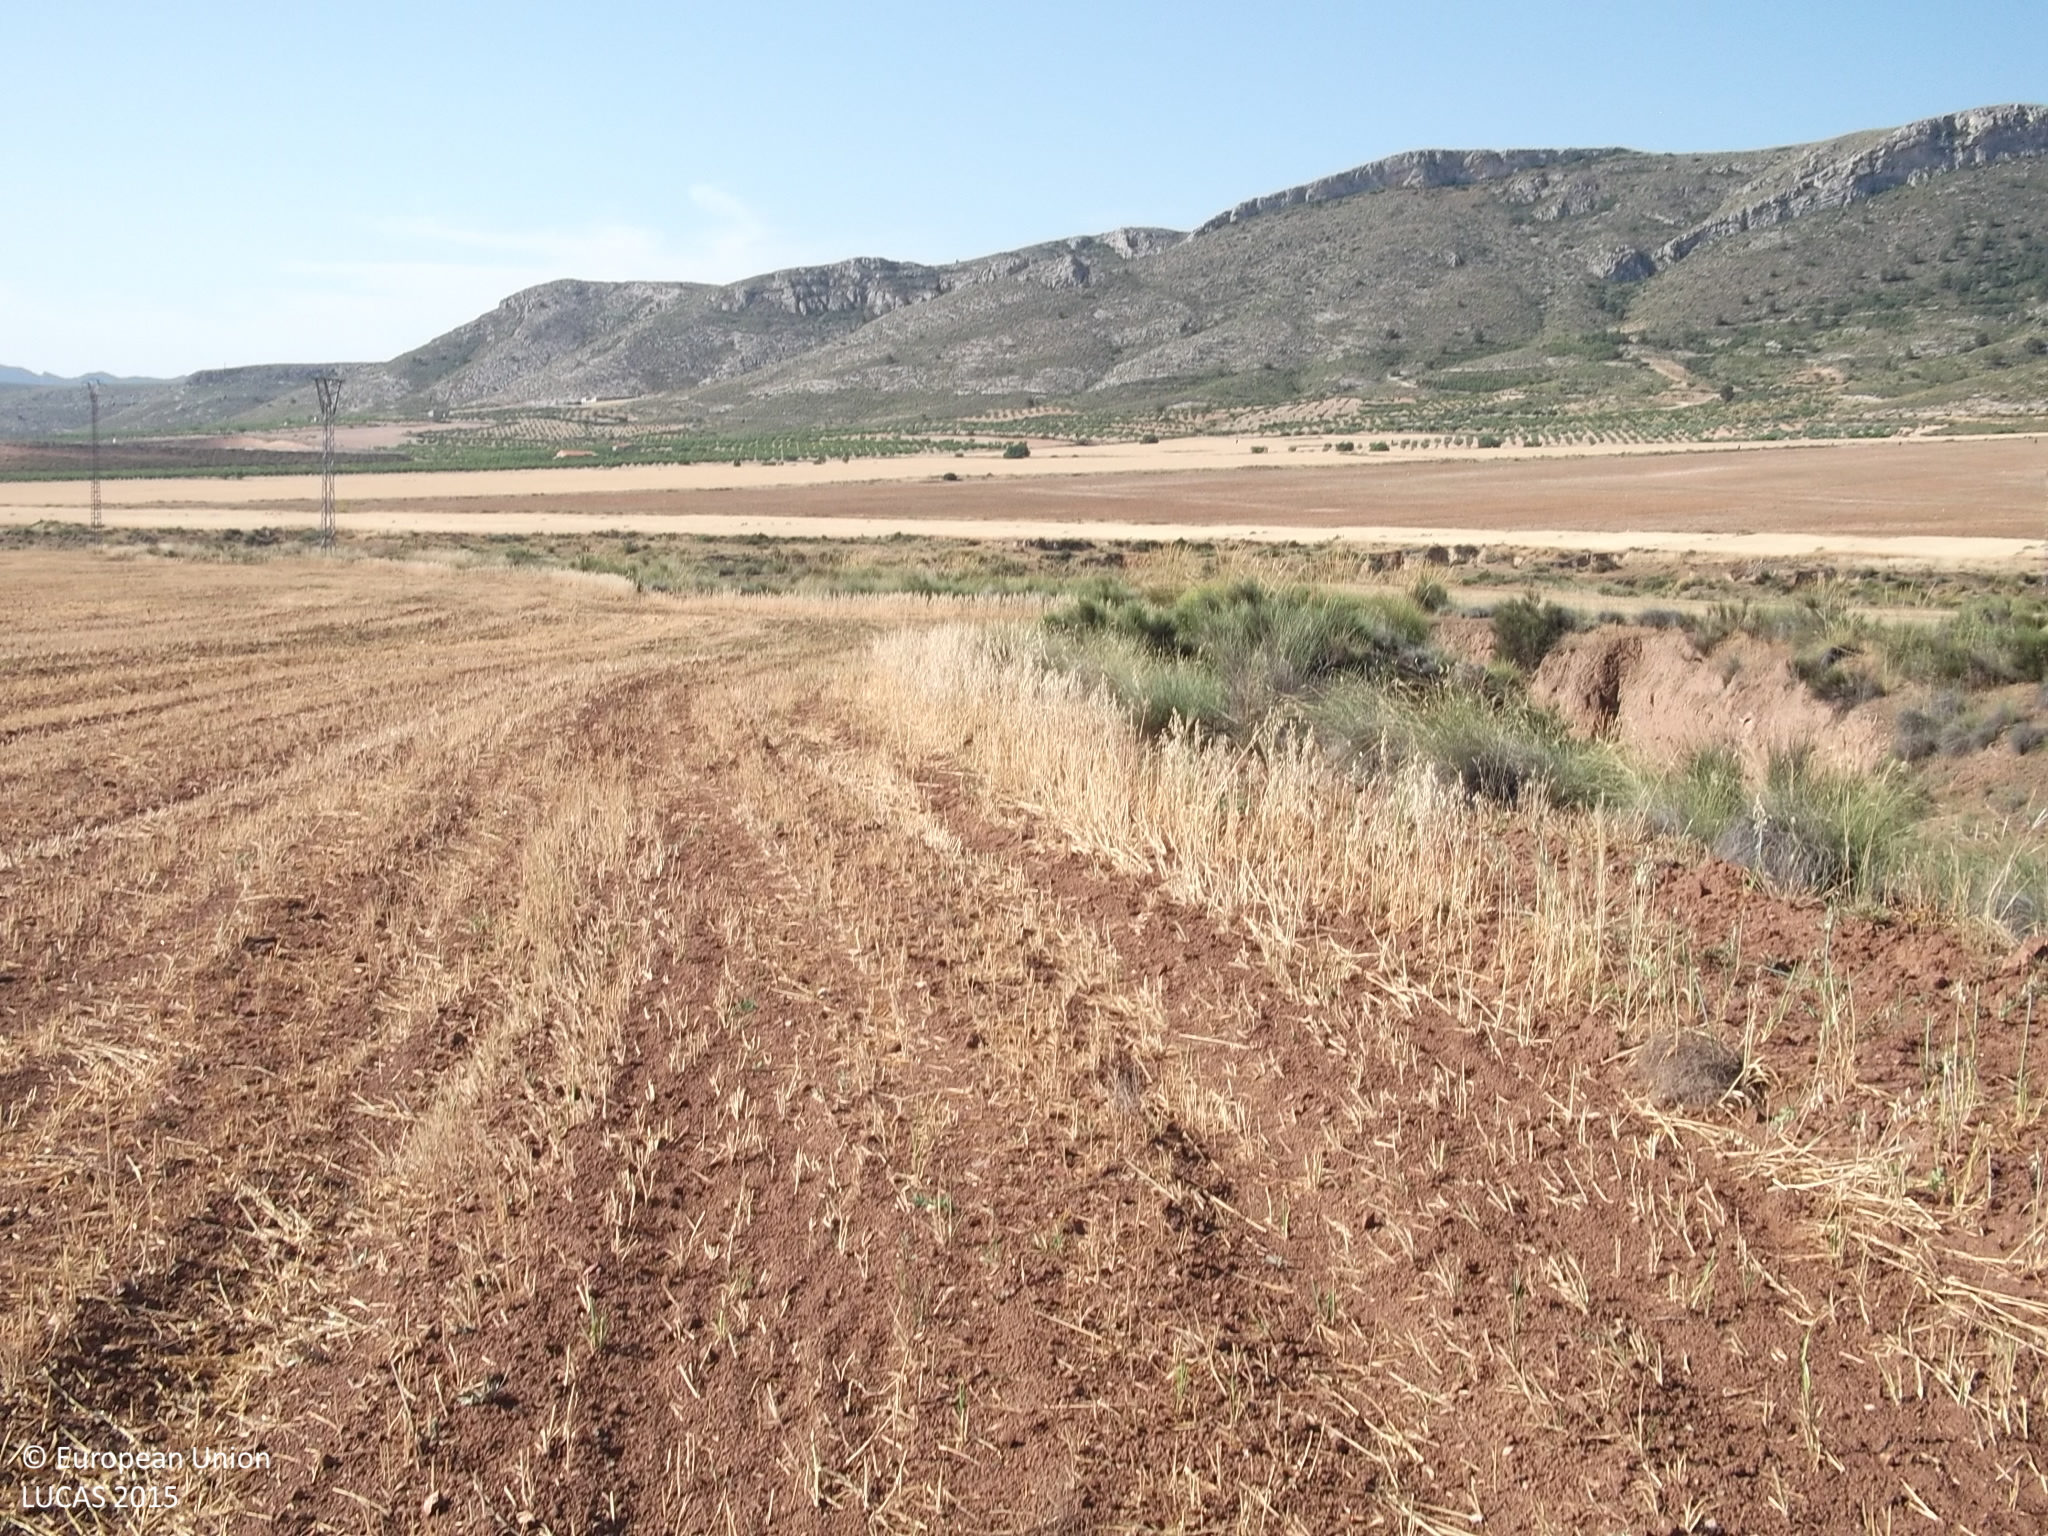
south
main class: Cropland
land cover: Oats
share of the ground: > 75 %
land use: Agriculture (excluding fallow land and kitchen gardens)
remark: Harvested field
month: June
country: ES
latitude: 38.4712
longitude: -1.3725
